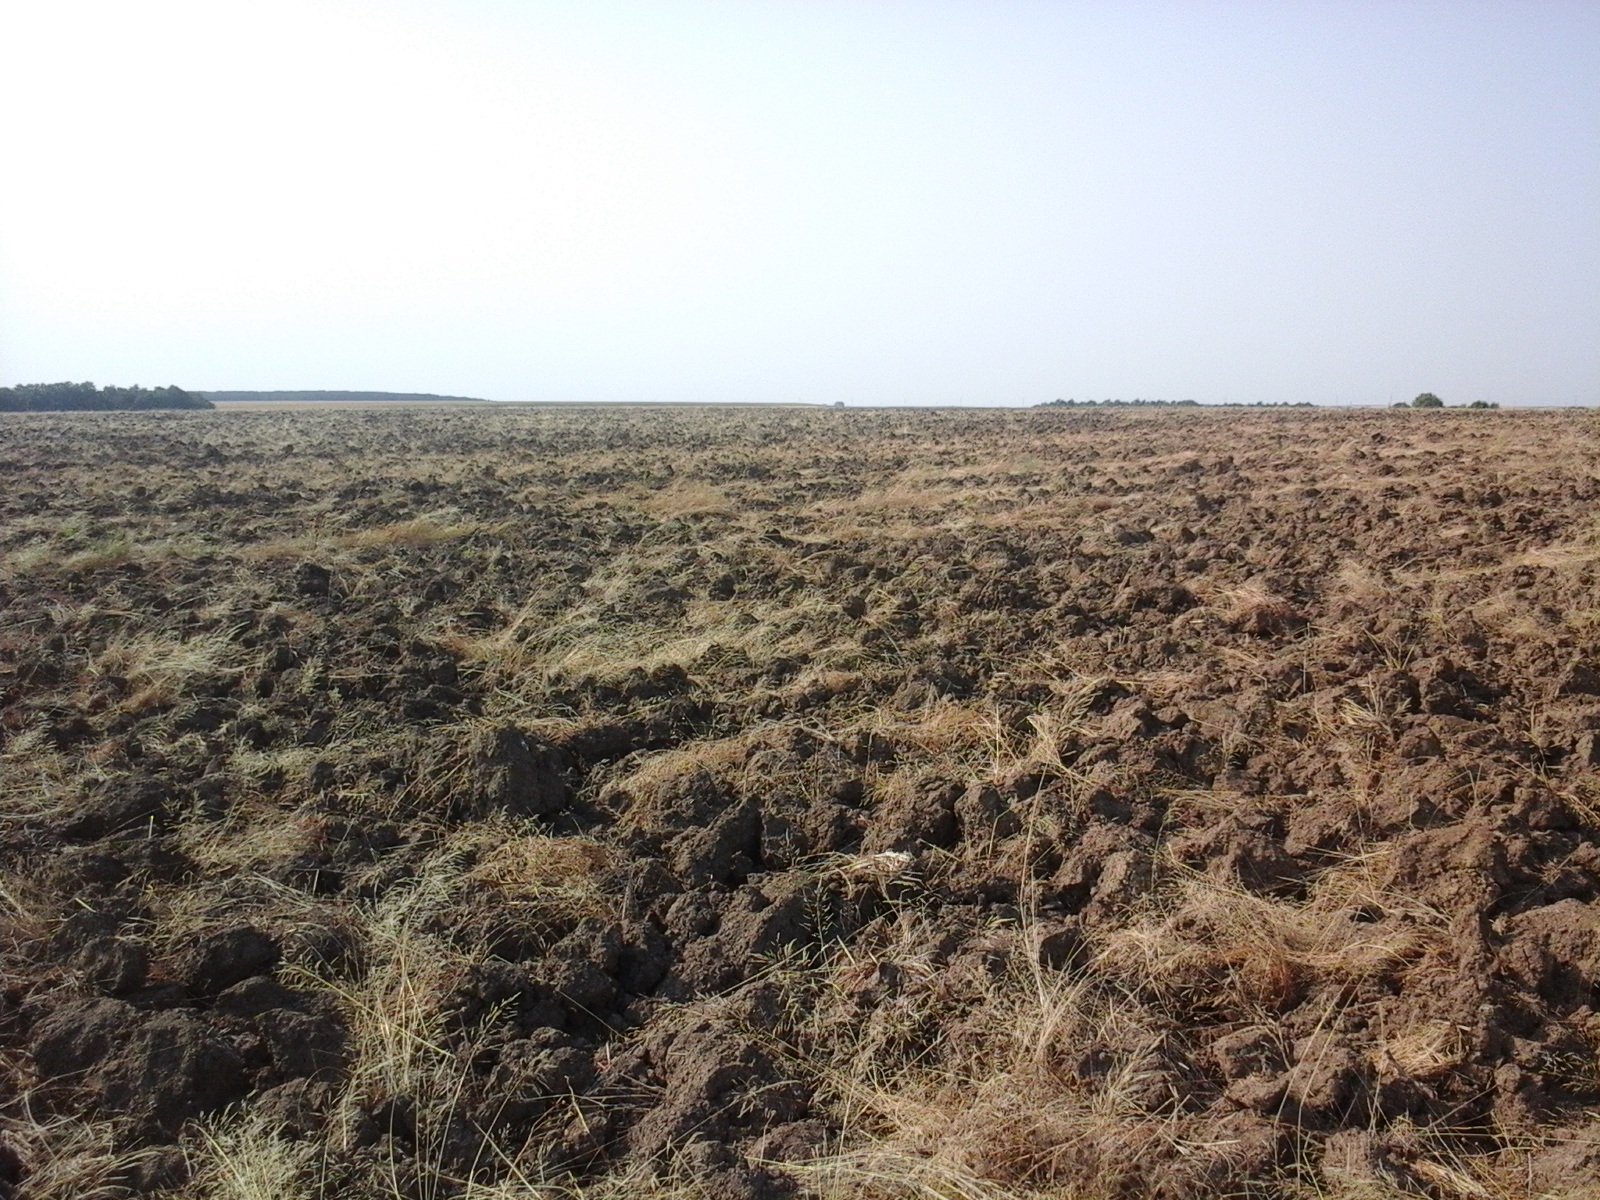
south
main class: Cropland
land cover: Temporary grasslands
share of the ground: 10 - 25 %
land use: Agriculture (excluding fallow land and kitchen gardens)
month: August
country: RO
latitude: 44.5717
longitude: 23.8228
